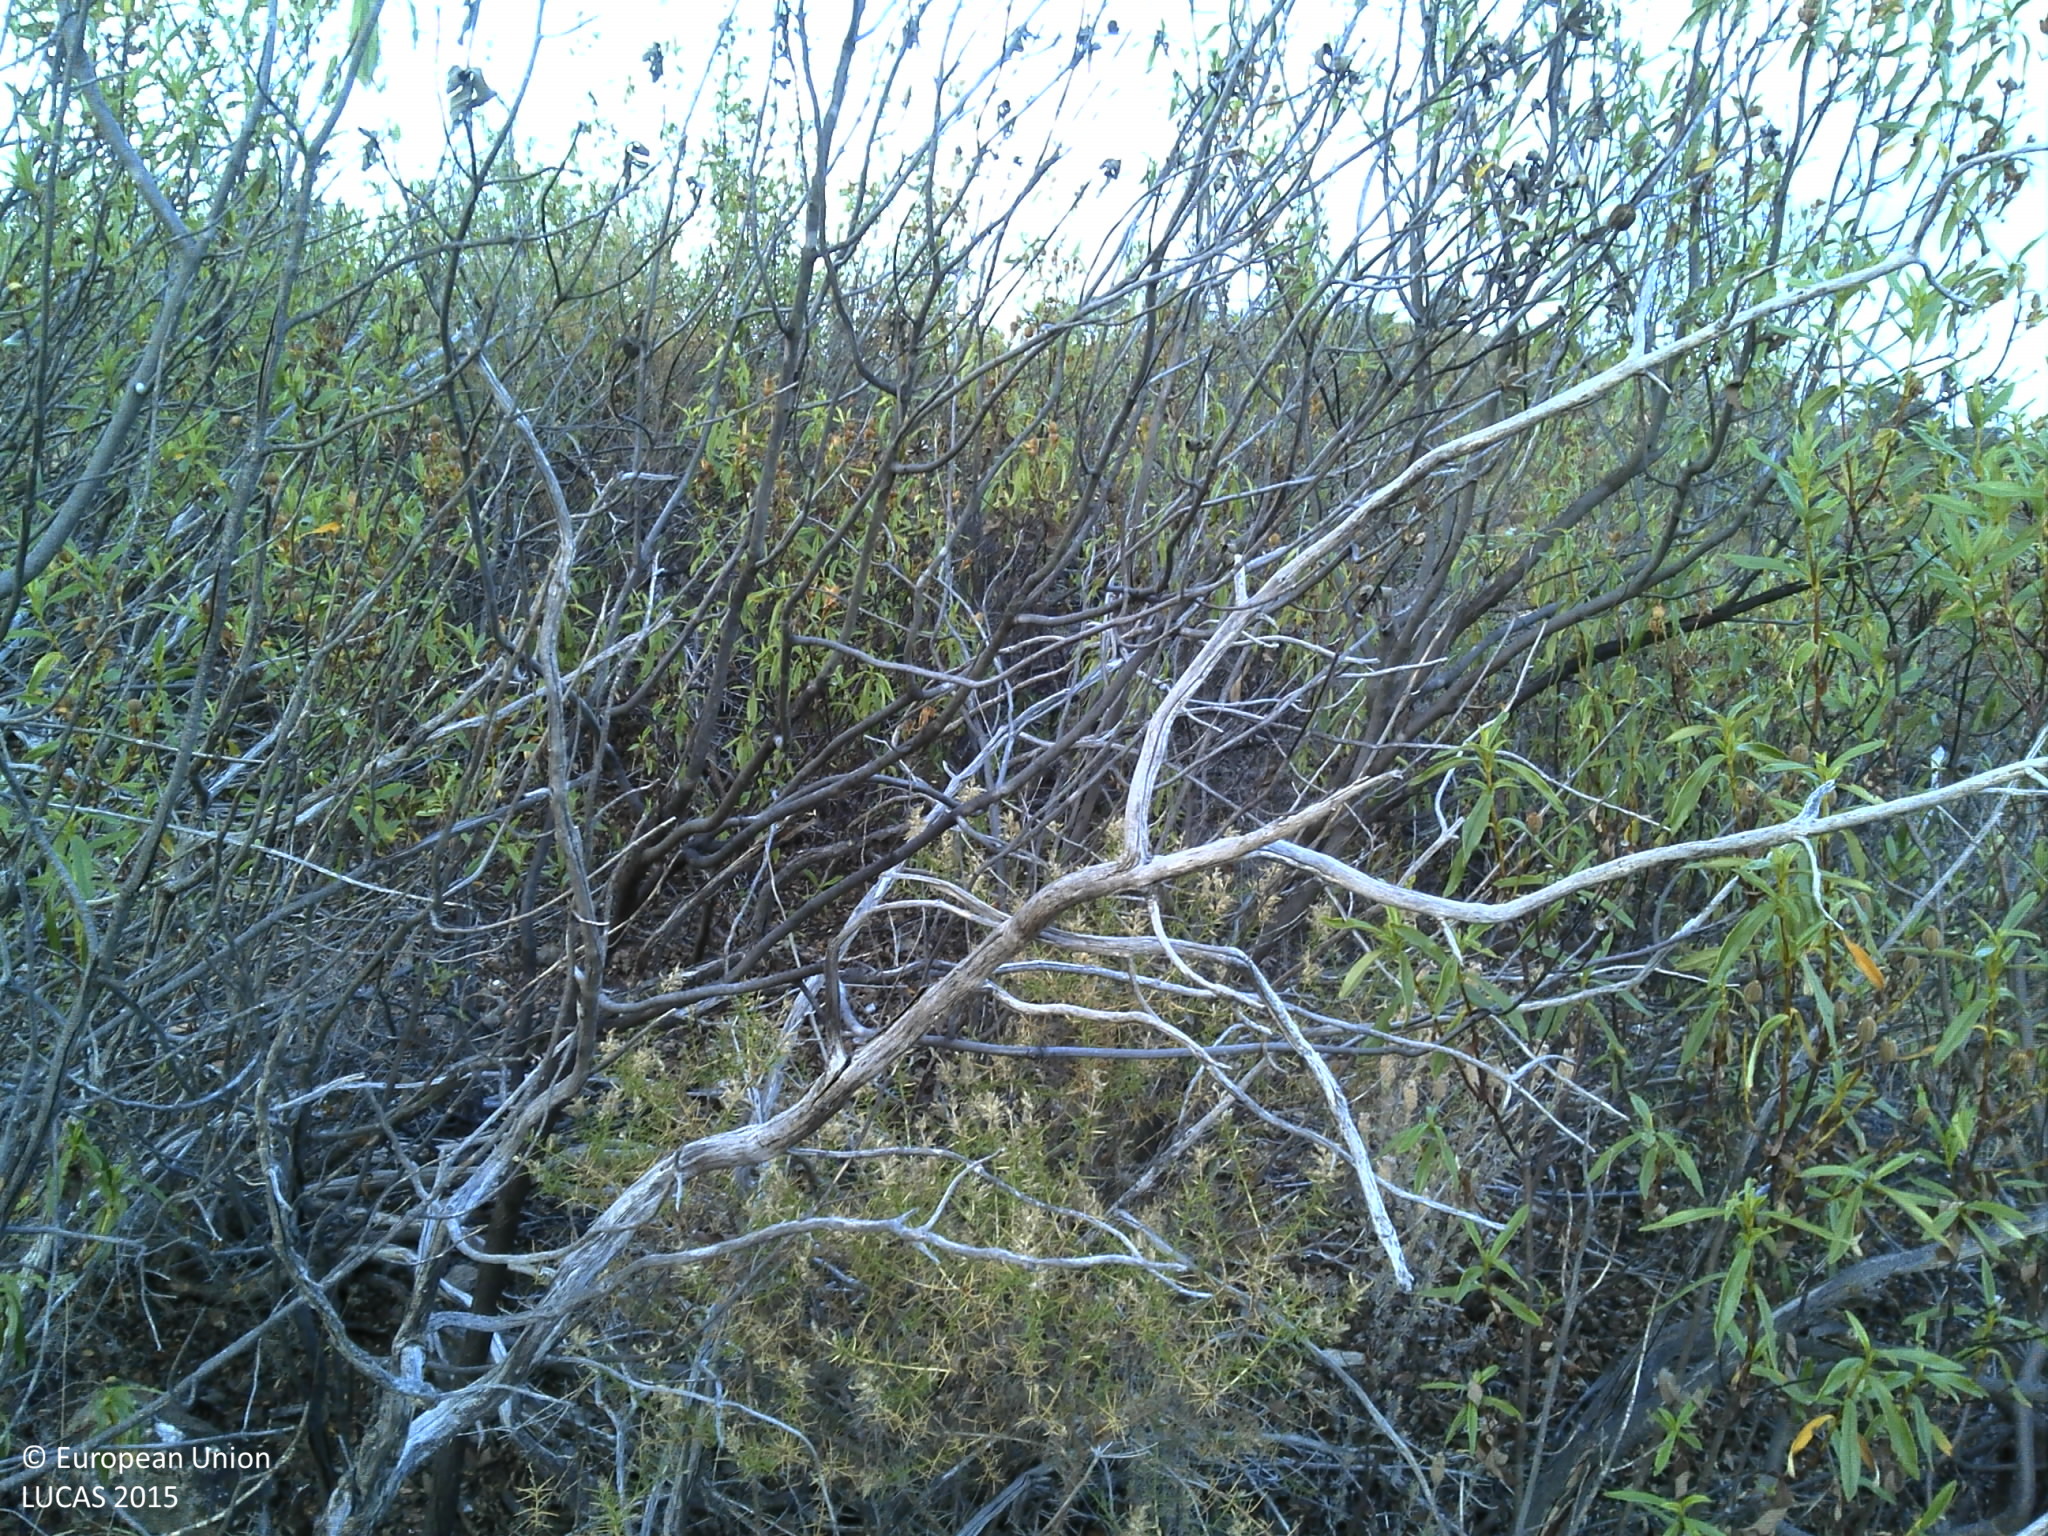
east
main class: Shrubland
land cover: Shrubland without tree cover
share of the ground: > 75 %
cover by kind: shrubs 90 %, unconsolidated bare surface 10 %
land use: Semi-natural and natural areas not in use
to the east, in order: Shrubland without tree cover; Shrubland with sparse tree cover; Broadleaved woodland; Other structural elements; Broadleaved woodland; Tracks; Broadleaved woodland
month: June
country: PT
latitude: 37.7880
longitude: -7.6299
